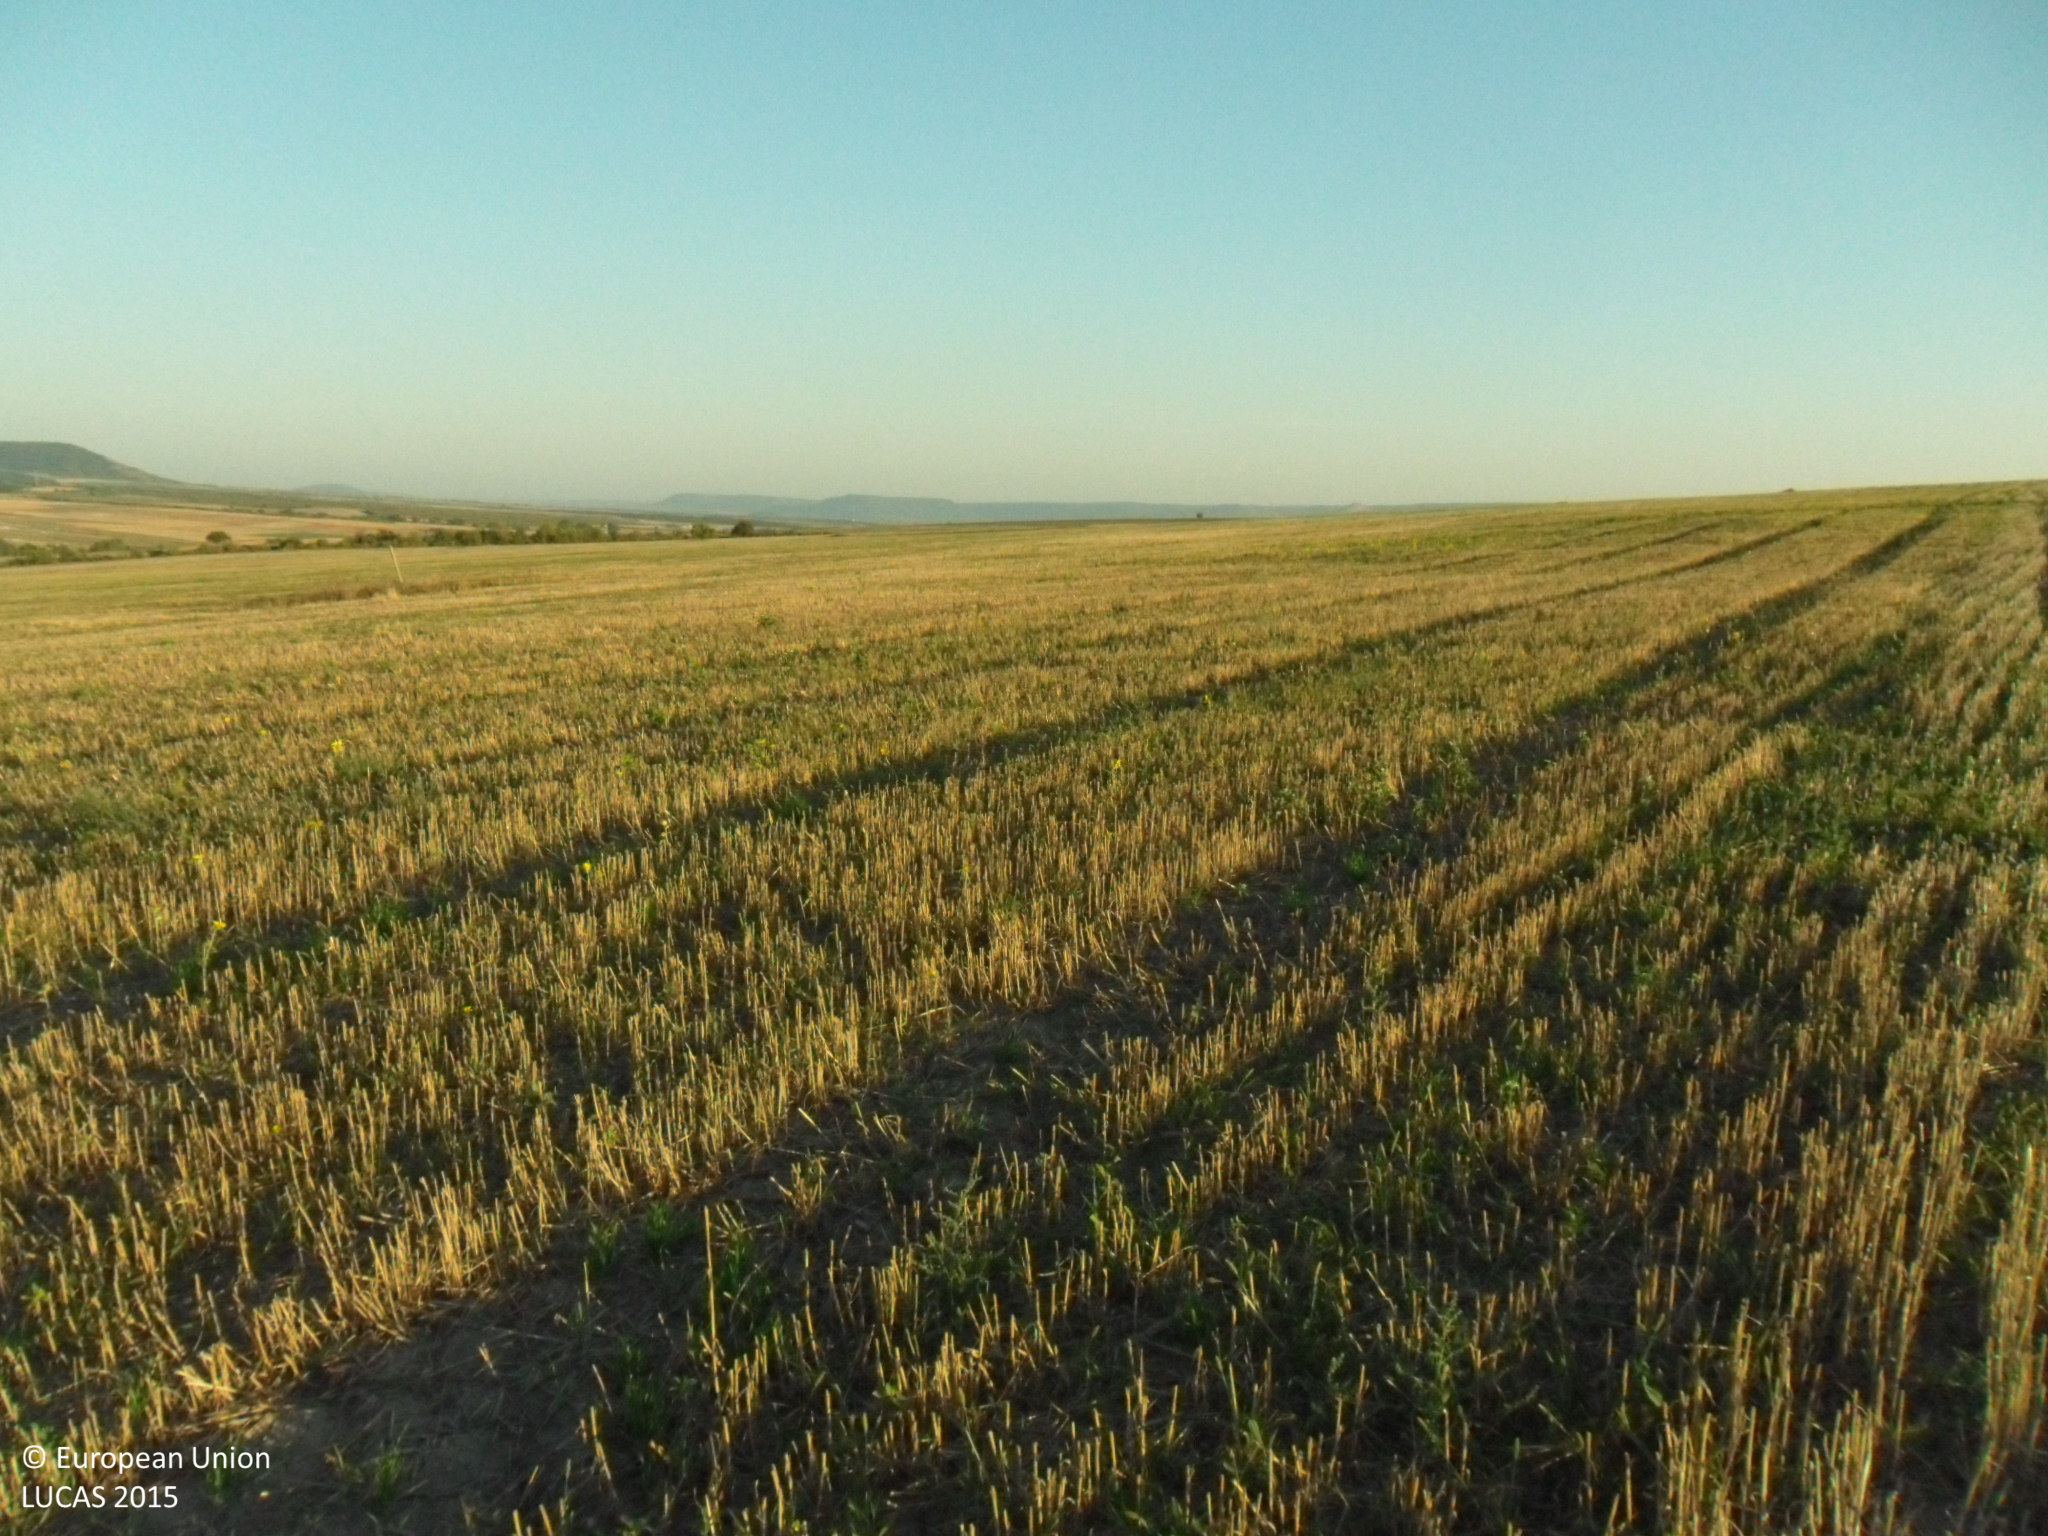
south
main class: Cropland
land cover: Common wheat
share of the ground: > 75 %
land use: Agriculture (excluding fallow land and kitchen gardens)
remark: Harvested field
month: September
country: BG
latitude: 43.4245
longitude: 27.1541
